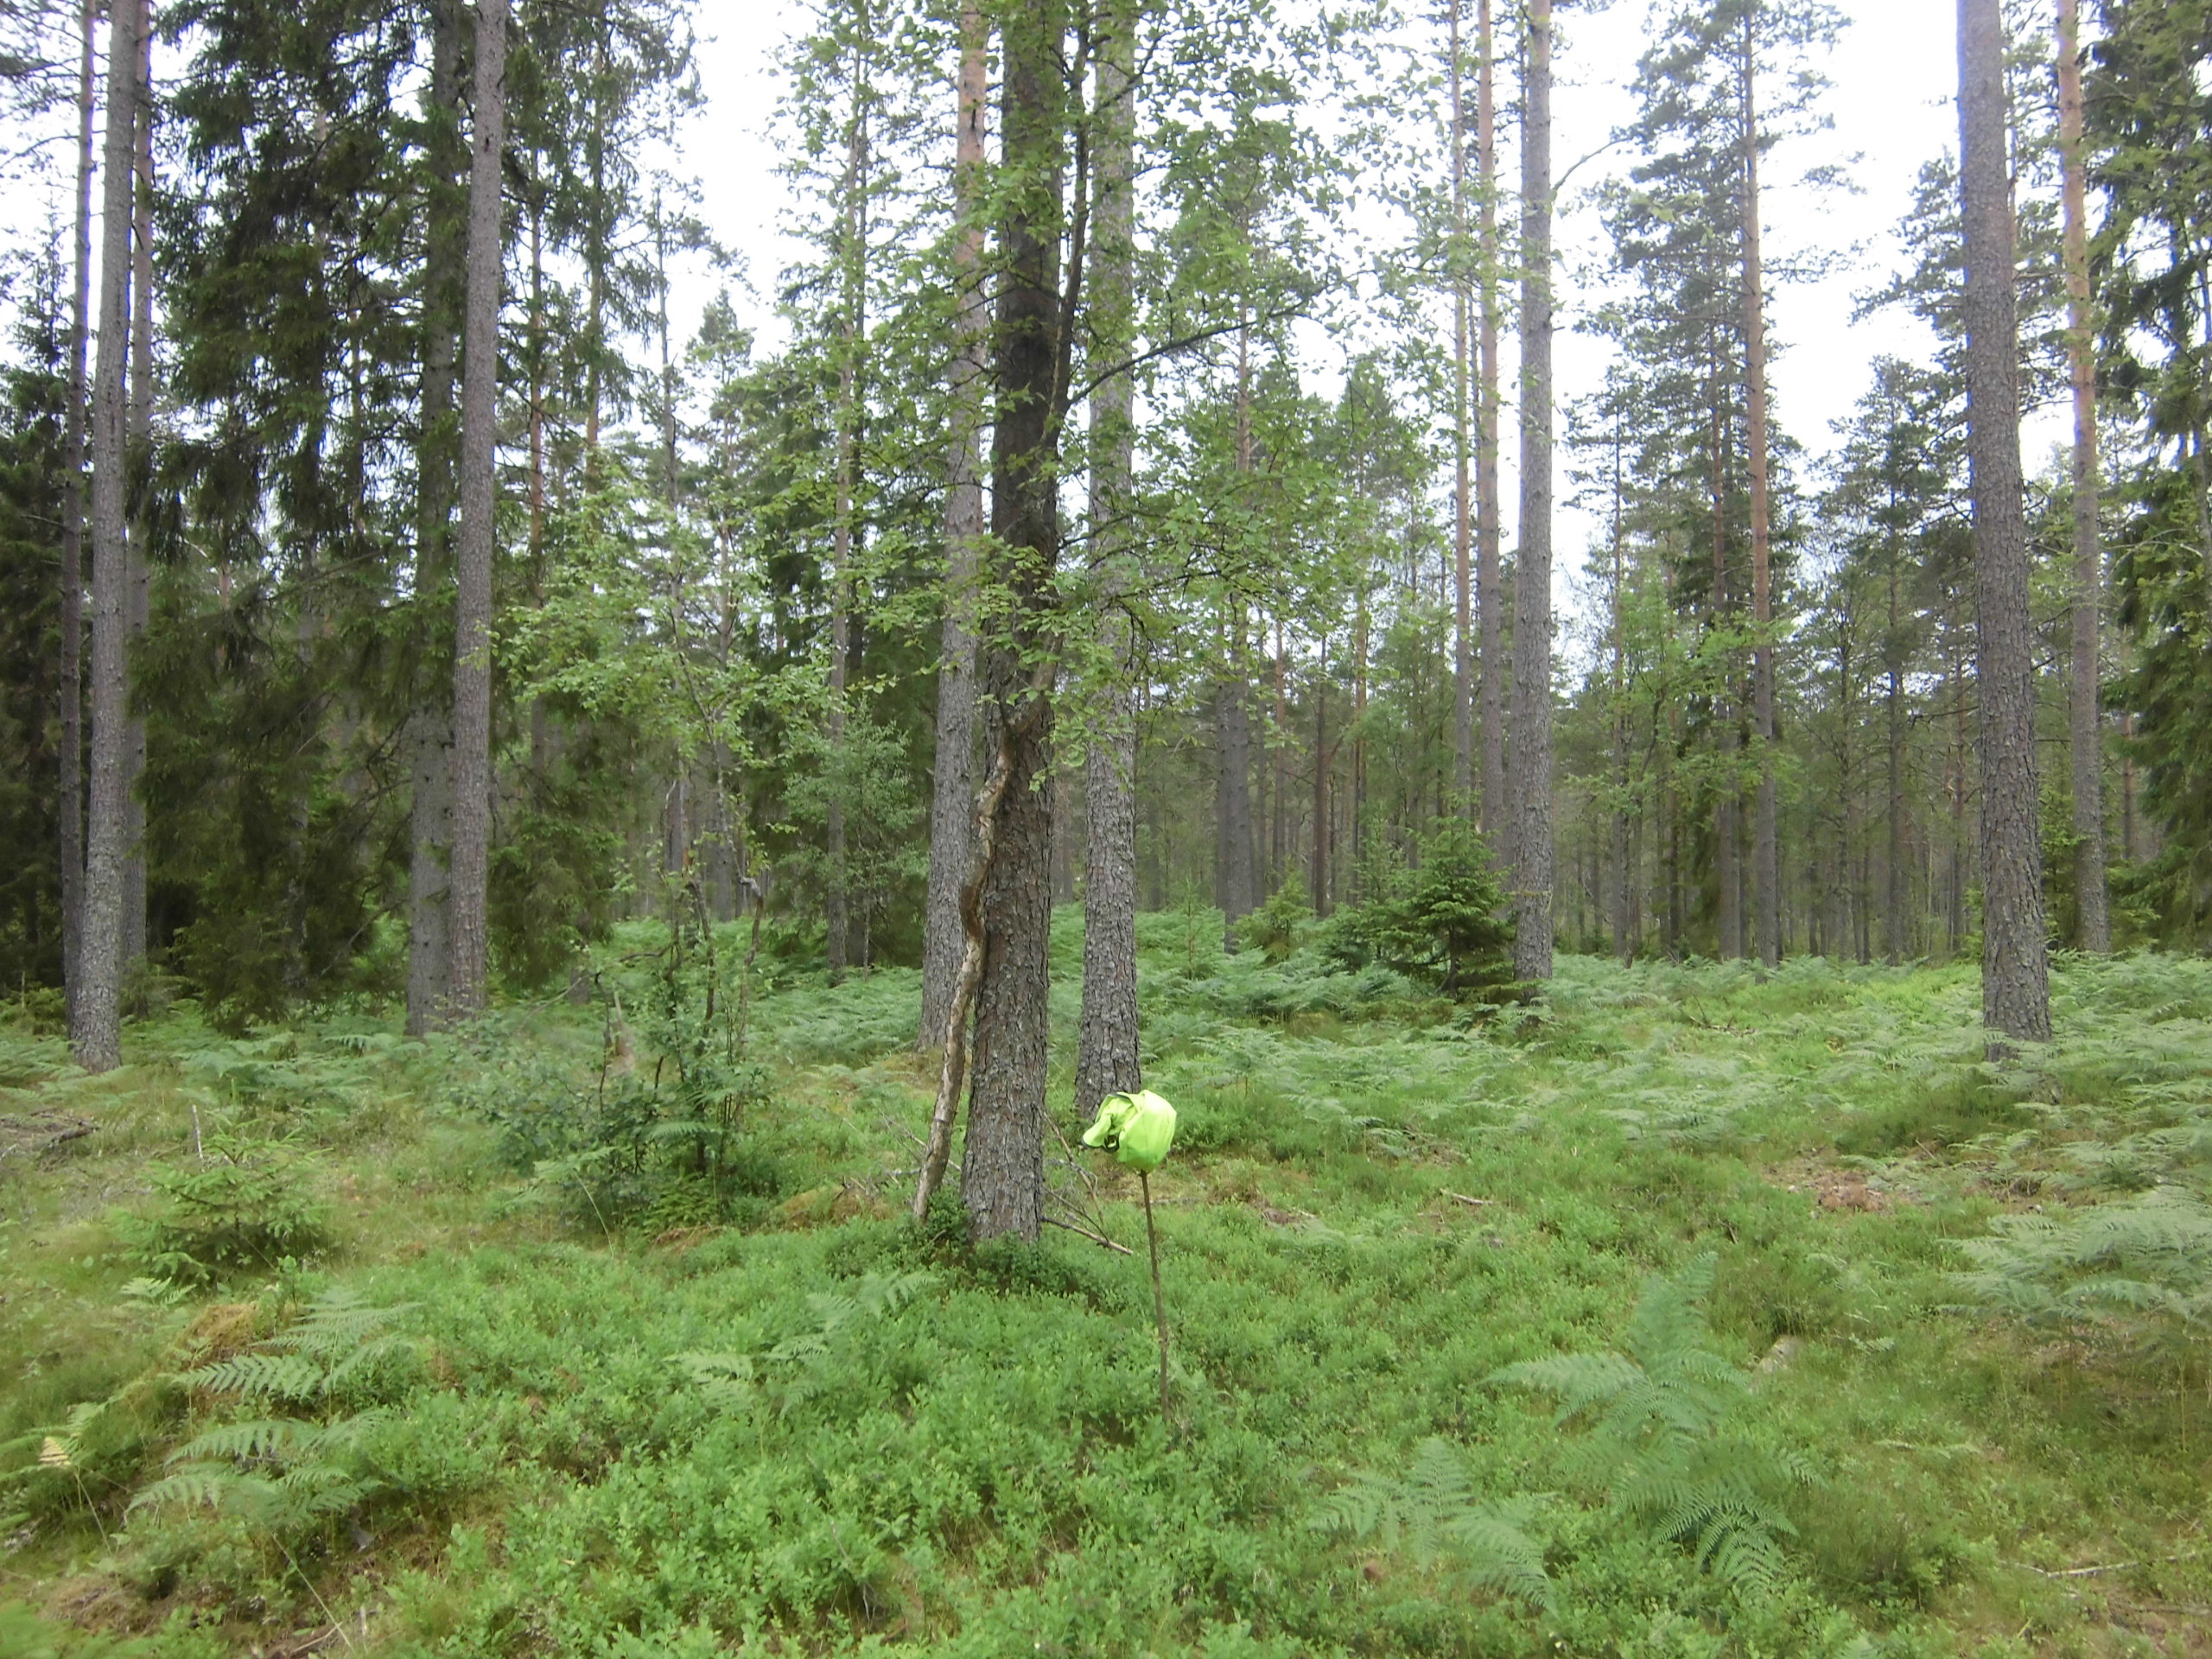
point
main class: Woodland
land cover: Pine dominated coniferous woodland
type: boreal forest
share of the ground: 25 - 50 %
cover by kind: coniferous forest trees 40 %, shrubs 40 %, herbaceous plants 10 %, broadleaved forest trees 5 %, lichens and mosses 5 %
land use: Forestry
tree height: > 5 m
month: July
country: SE
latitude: 57.2749
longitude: 15.1215
